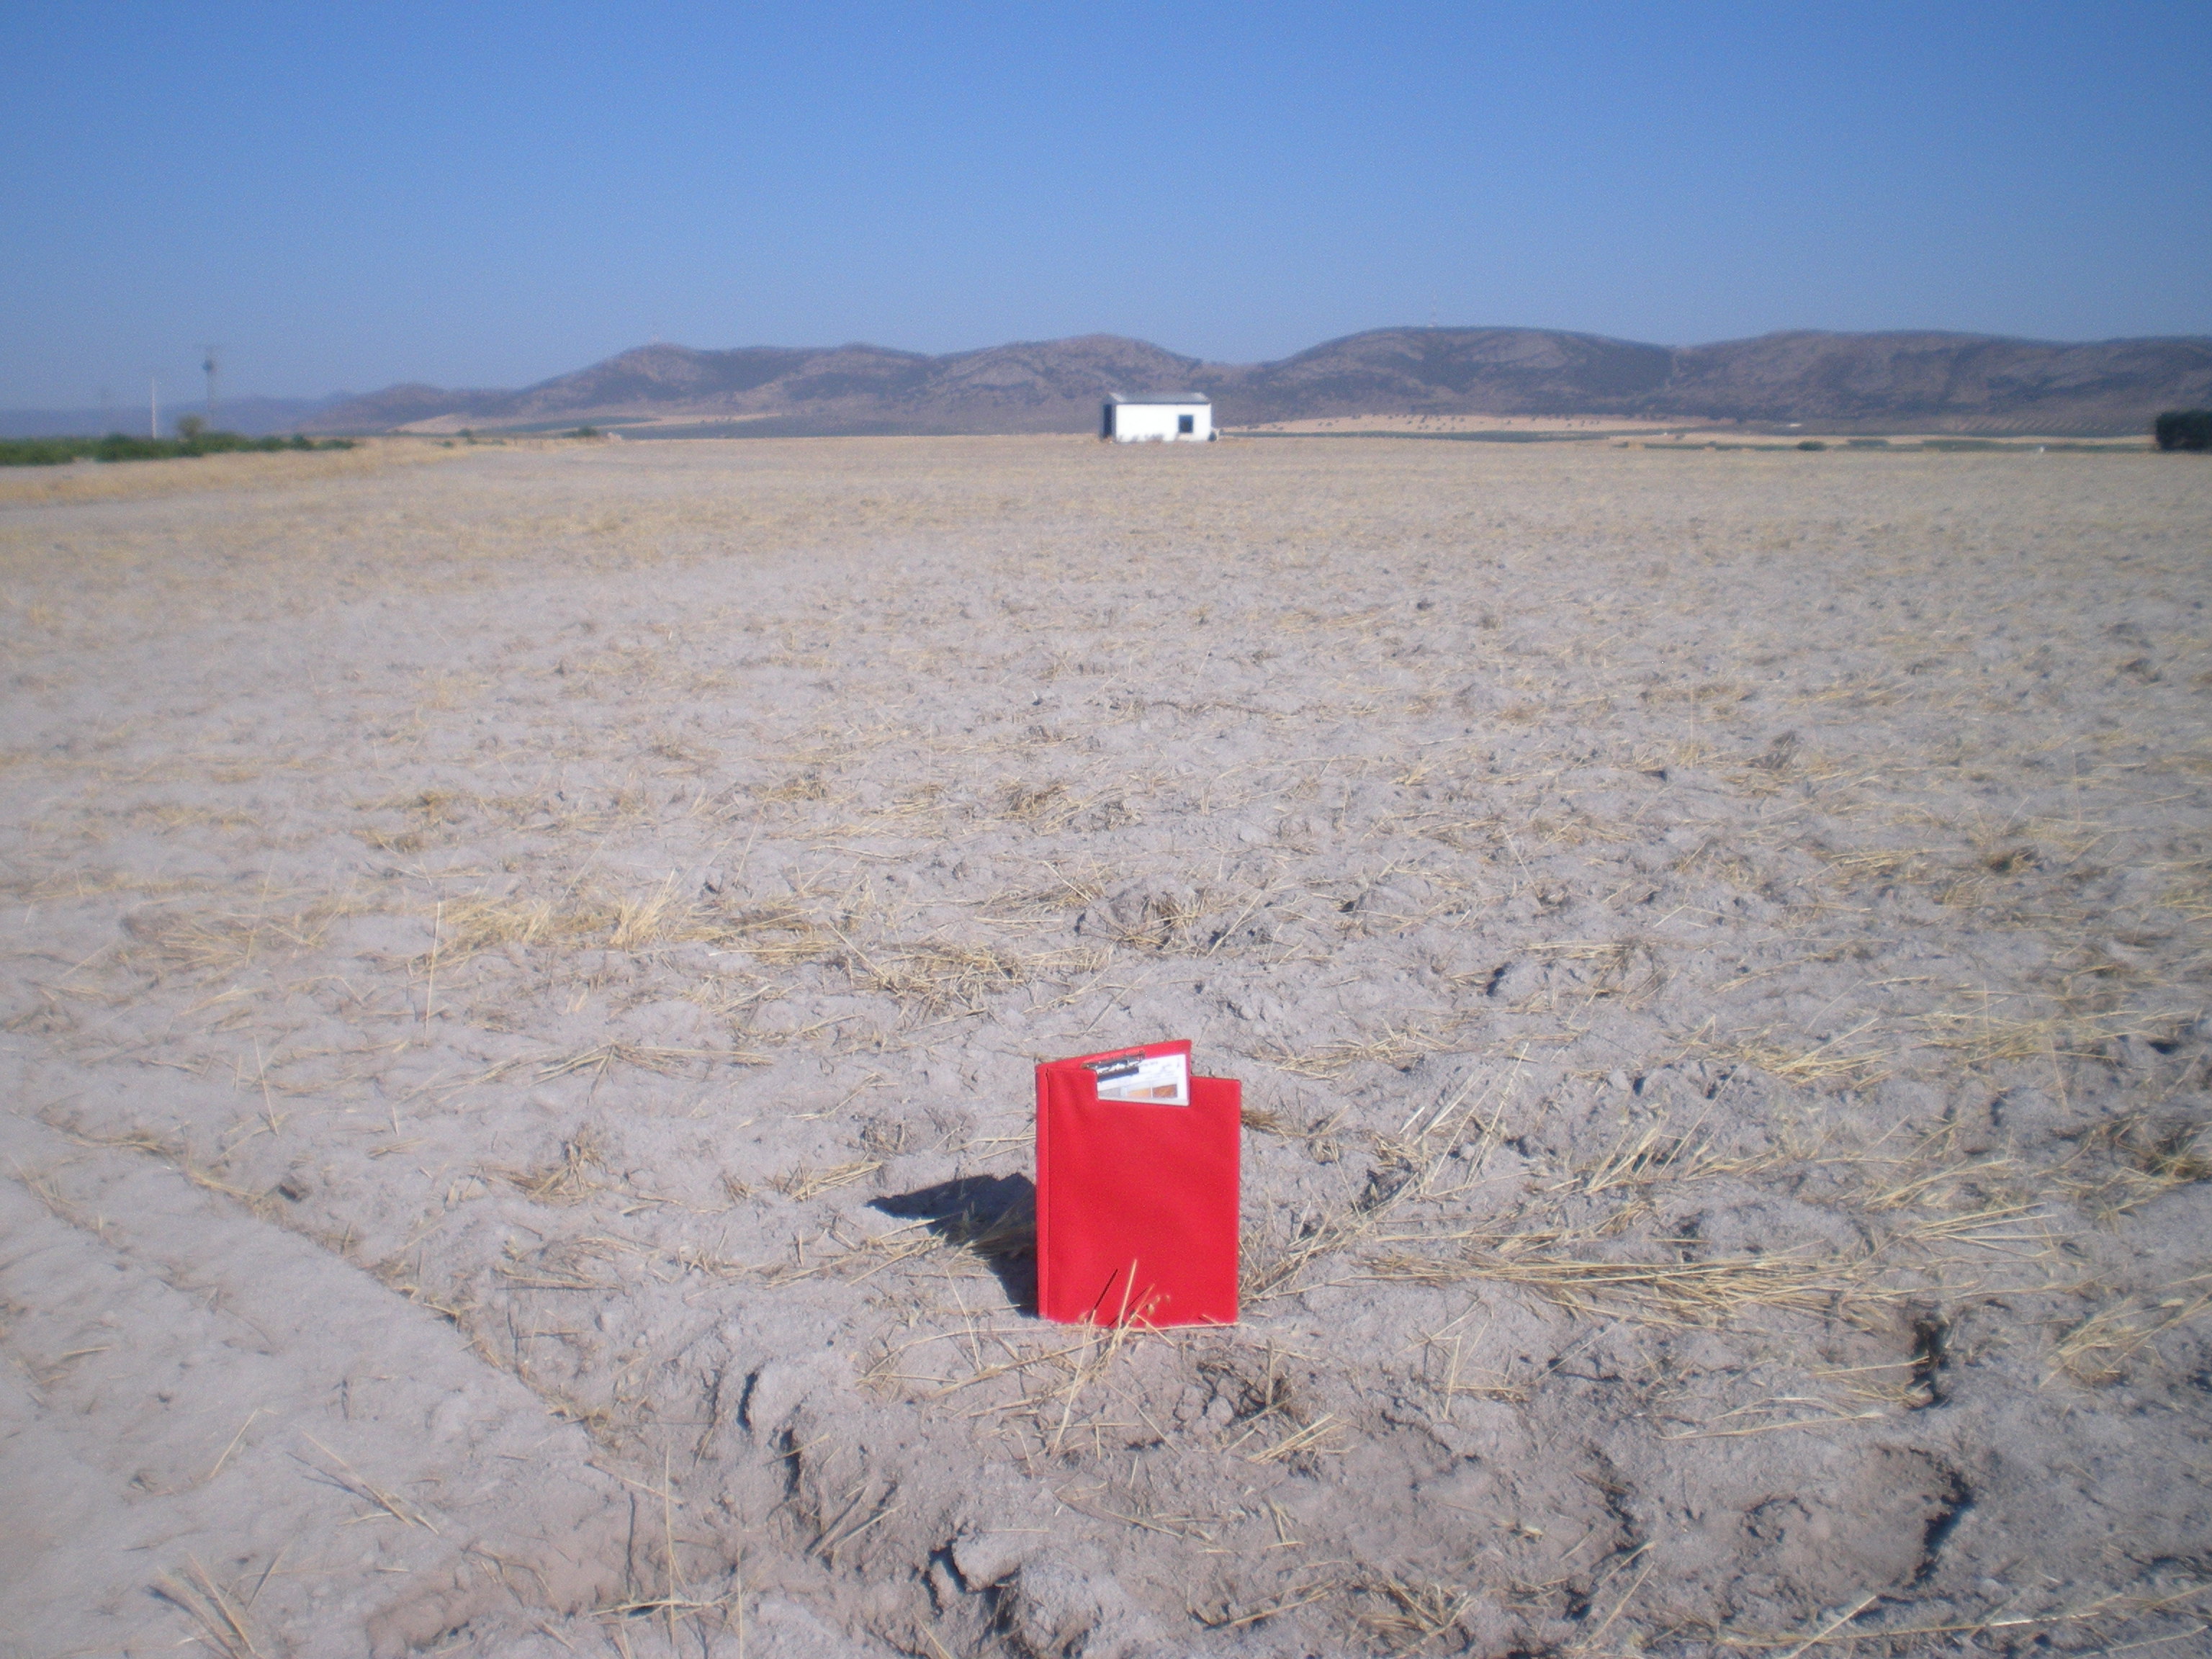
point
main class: Cropland
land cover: Common wheat
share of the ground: < 10 %
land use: Agriculture (excluding fallow land and kitchen gardens)
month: July
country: ES
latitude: 39.2968
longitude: -3.3410
